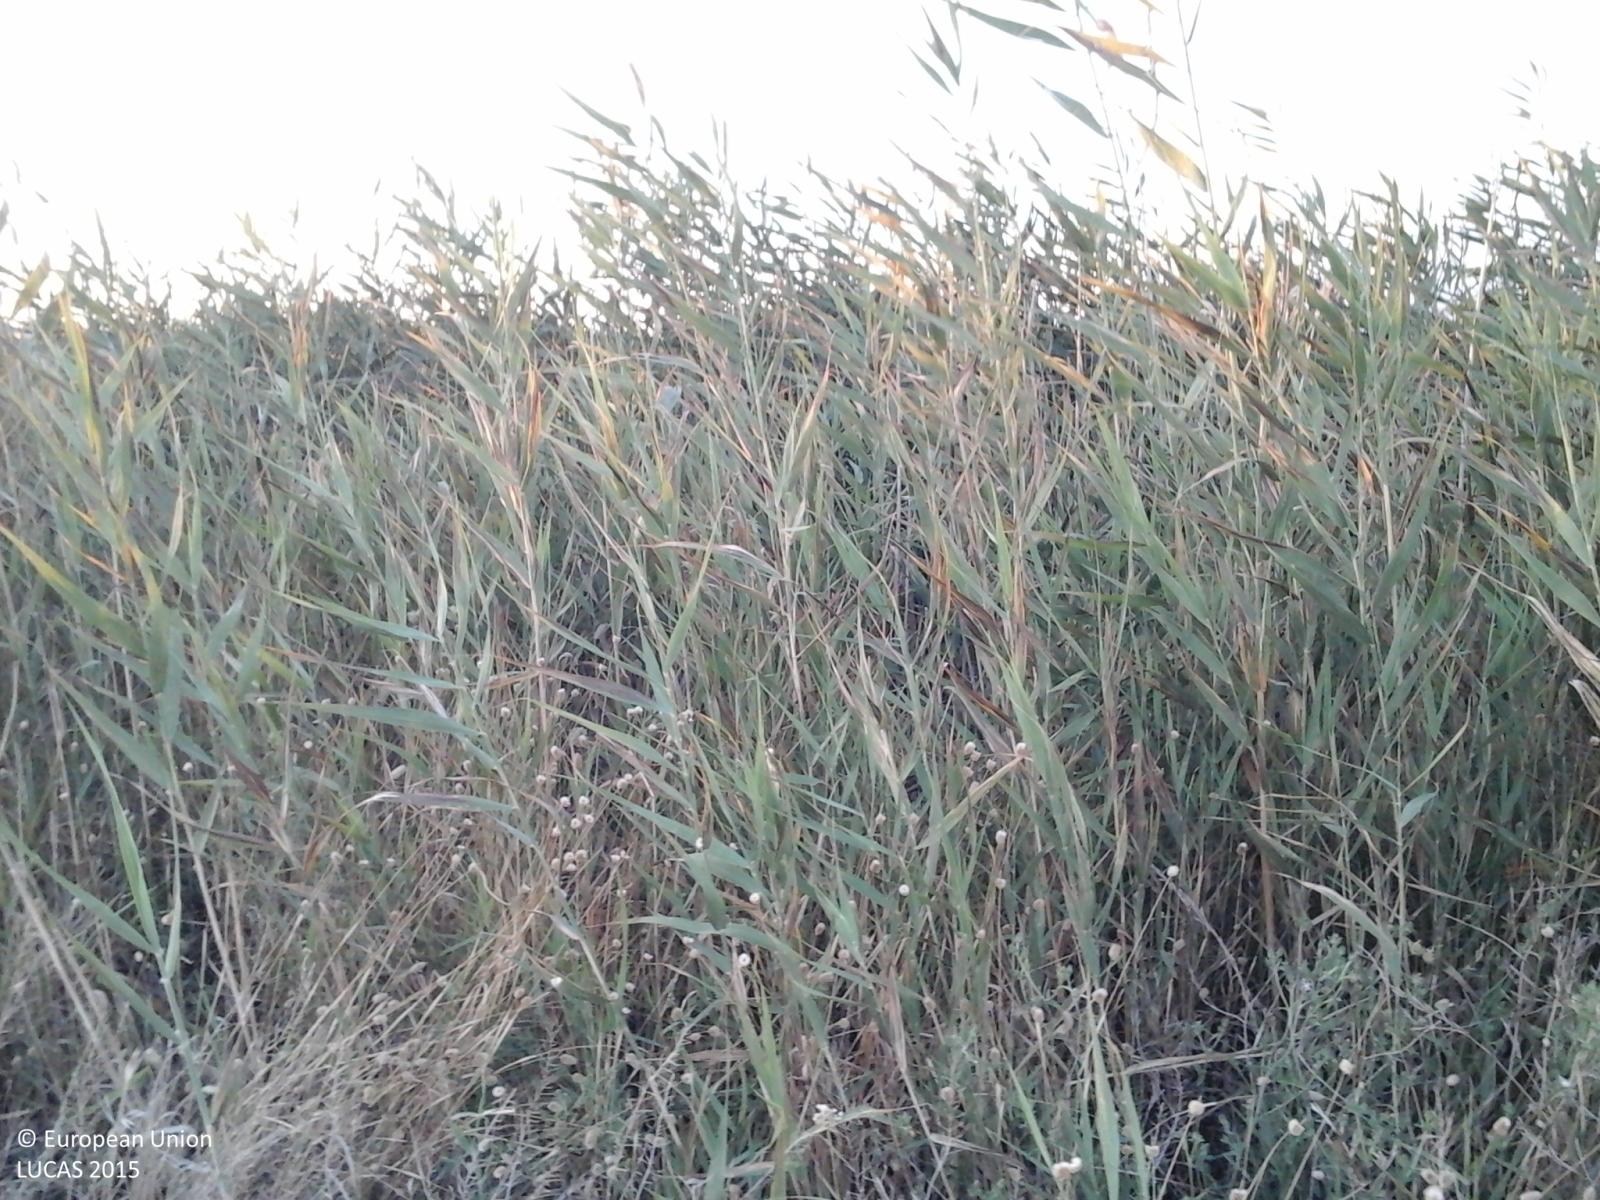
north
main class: Cropland
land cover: Mixed cereals for fodder
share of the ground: > 75 %
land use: Agriculture (excluding fallow land and kitchen gardens)
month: June
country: IT
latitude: 37.4800
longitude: 14.8163
